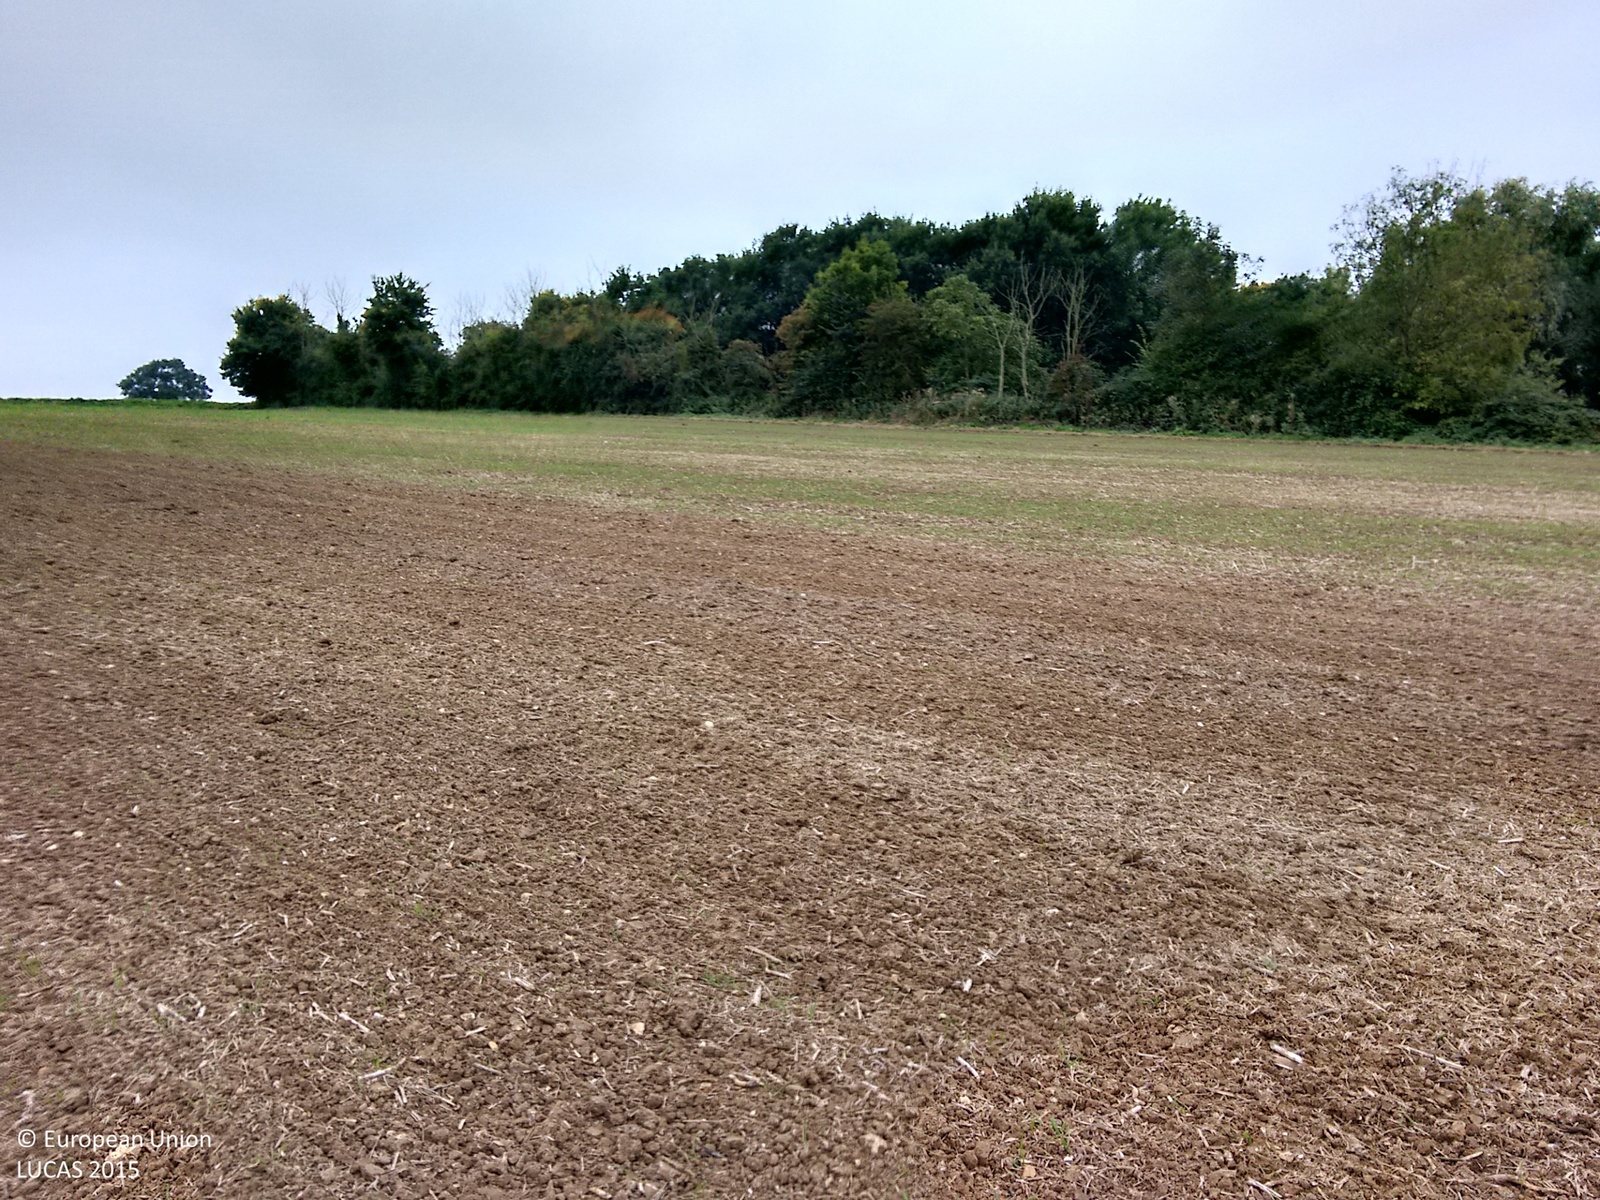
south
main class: Cropland
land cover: Common wheat
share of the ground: < 10 %
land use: Agriculture (excluding fallow land and kitchen gardens)
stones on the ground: 10 - 25 %
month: October
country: GB
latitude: 52.3210
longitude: 0.9537
